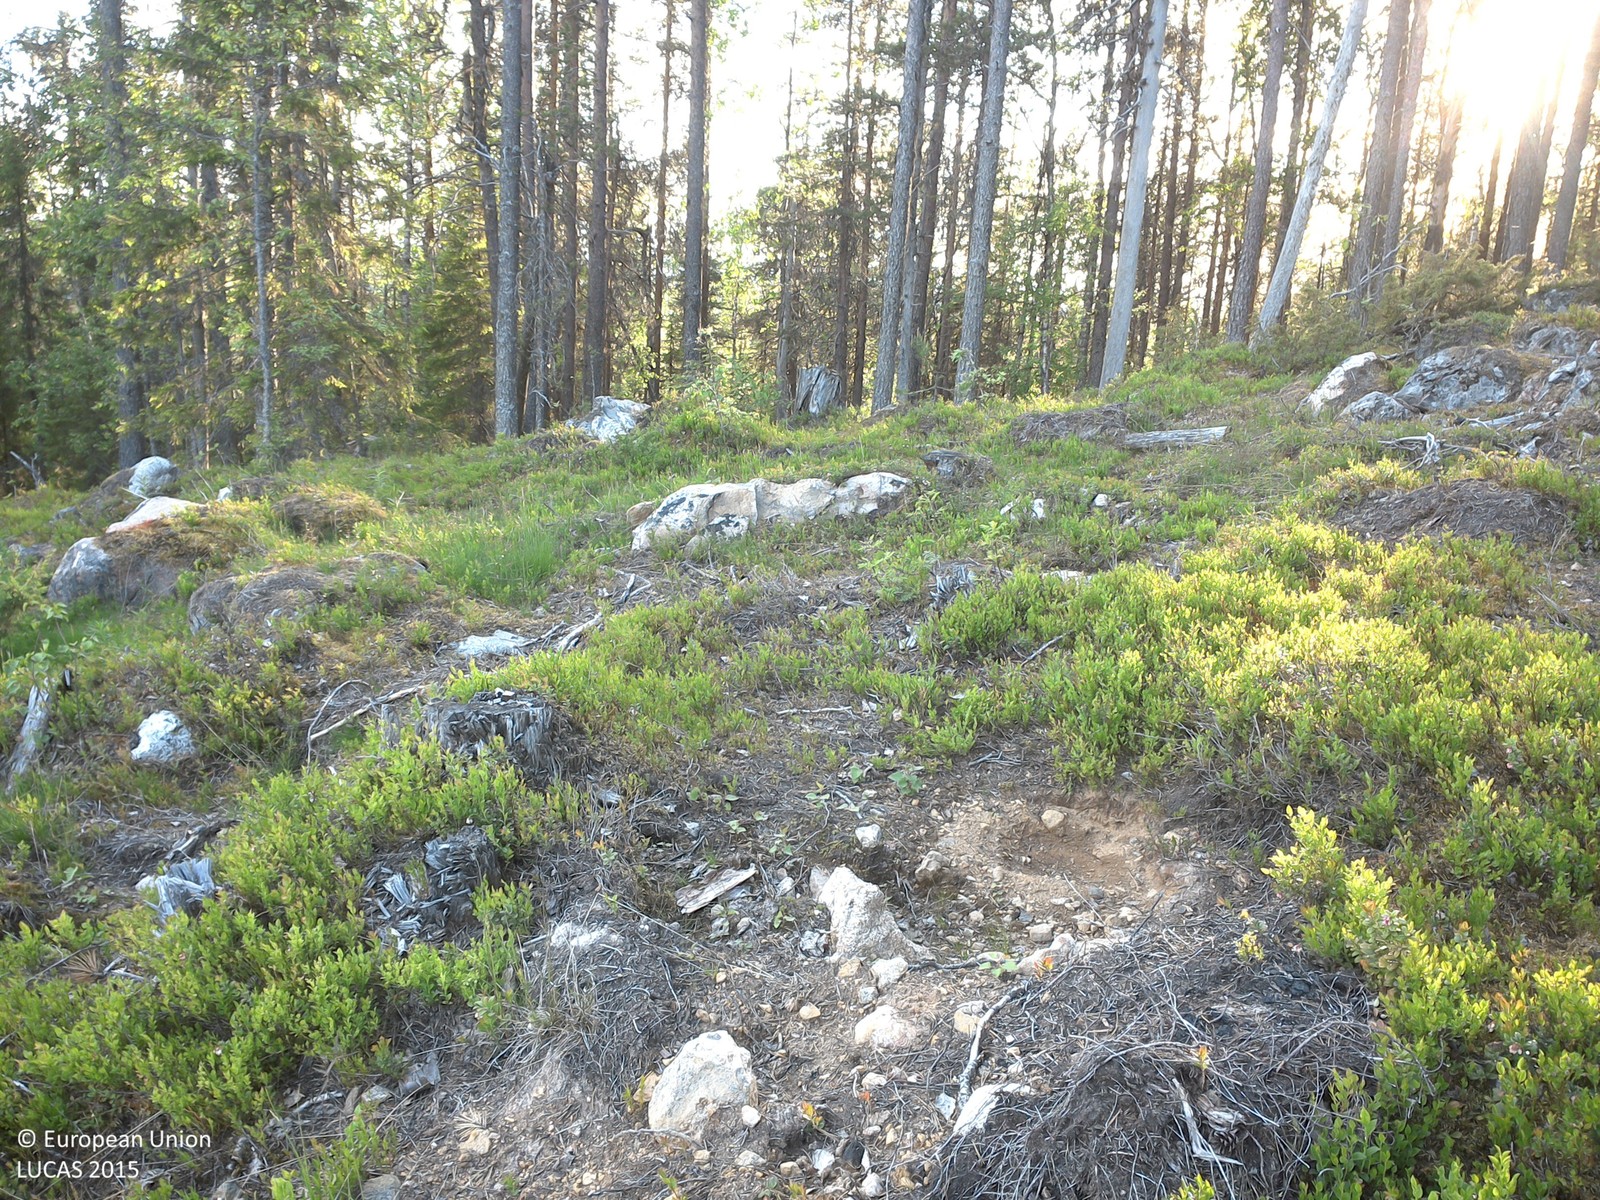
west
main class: Shrubland
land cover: Shrubland with sparse tree cover
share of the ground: 50 - 75 %
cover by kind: shrubs 50 %, unconsolidated bare surface 30 %, herbaceous plants 15 %, broadleaved forest trees 5 %
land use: Forestry
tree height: < 5 m
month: June
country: SE
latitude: 66.7515
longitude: 22.9367
